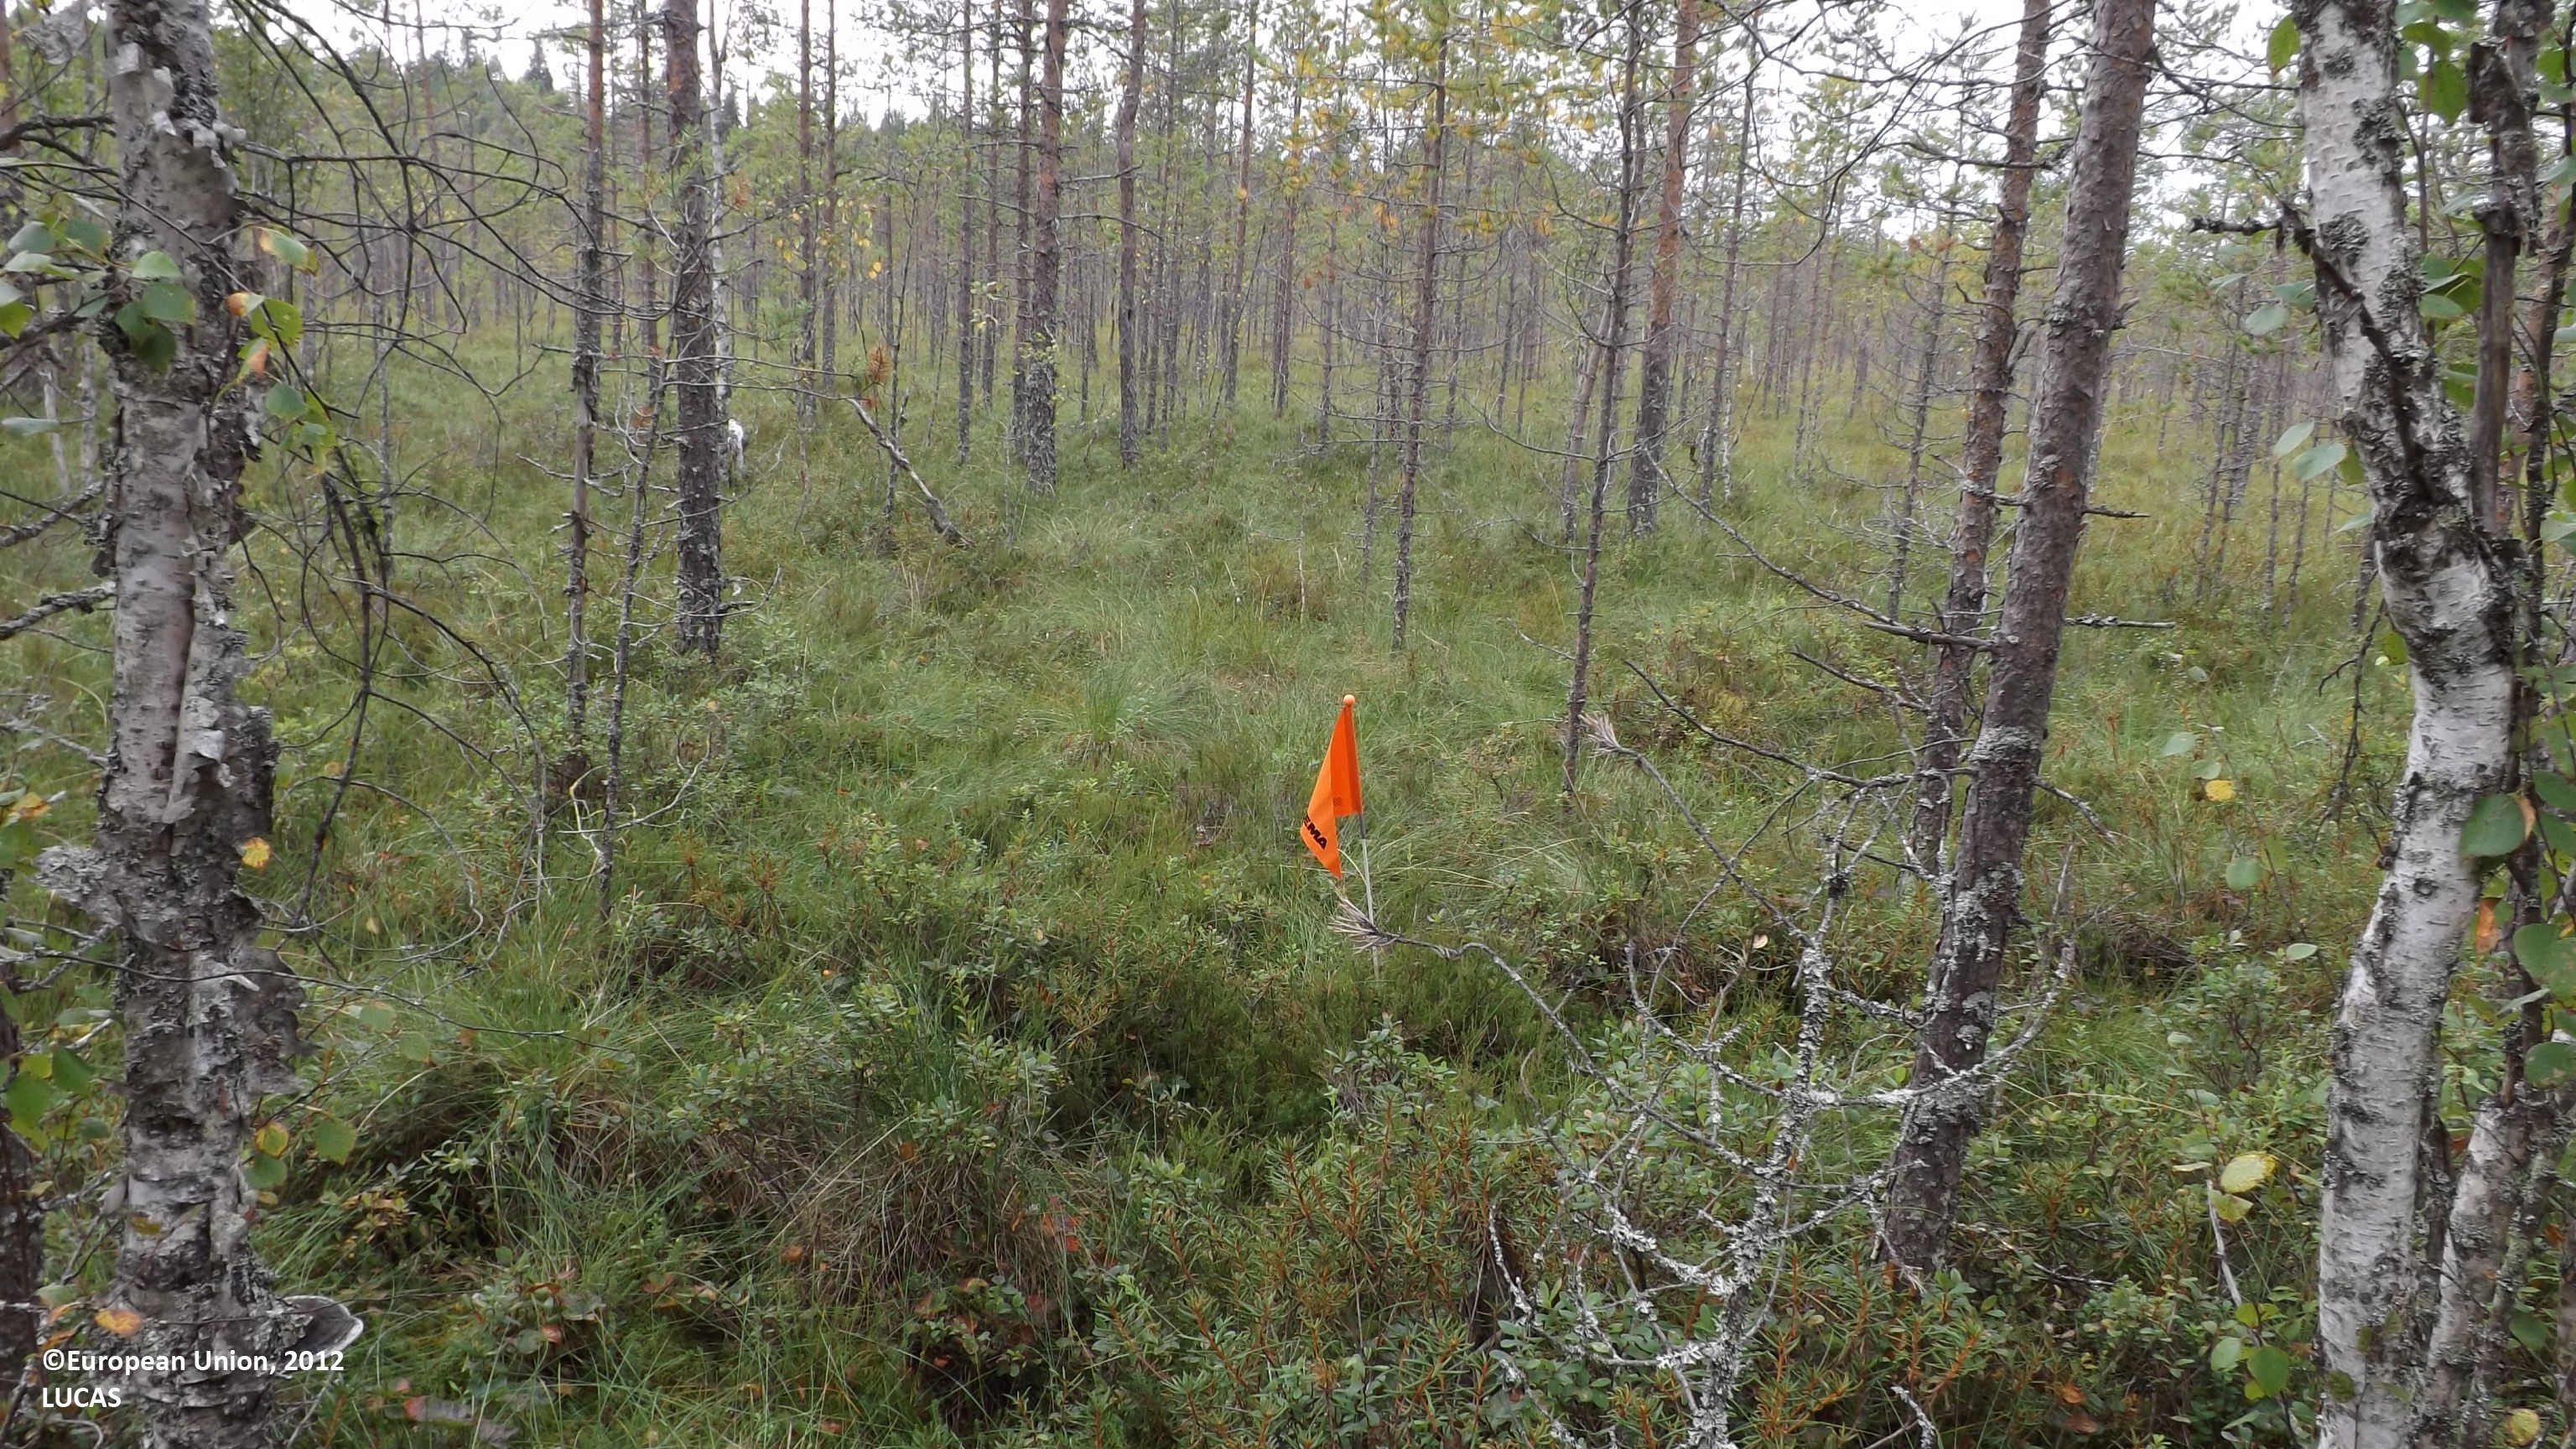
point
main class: Woodland
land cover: Pine dominated mixed woodland
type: mire and swamp forests
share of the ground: 25 - 50 %
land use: Semi-natural and natural areas not in use
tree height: > 5 m
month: August
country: FI
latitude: 63.7030
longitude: 23.9669
